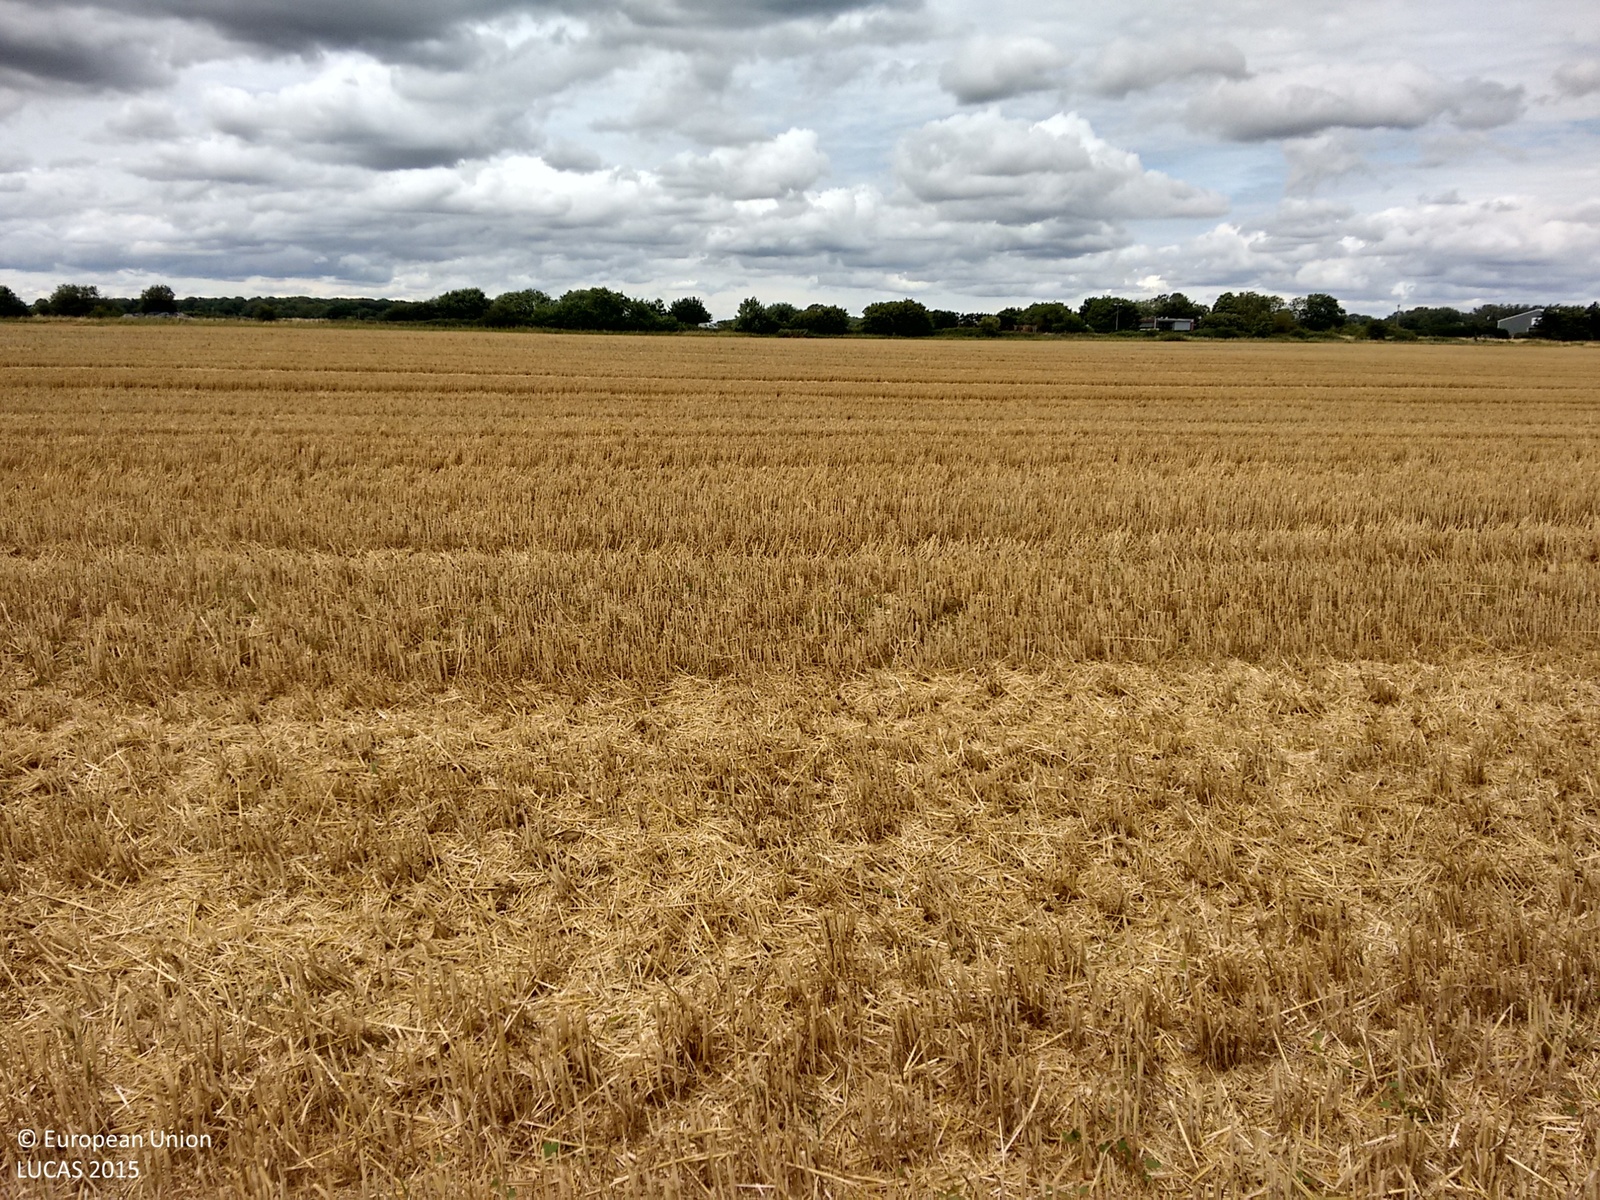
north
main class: Cropland
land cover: Common wheat
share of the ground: > 75 %
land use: Agriculture (excluding fallow land and kitchen gardens)
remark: Harvested field
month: August
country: GB
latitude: 52.6047
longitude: 0.4182
